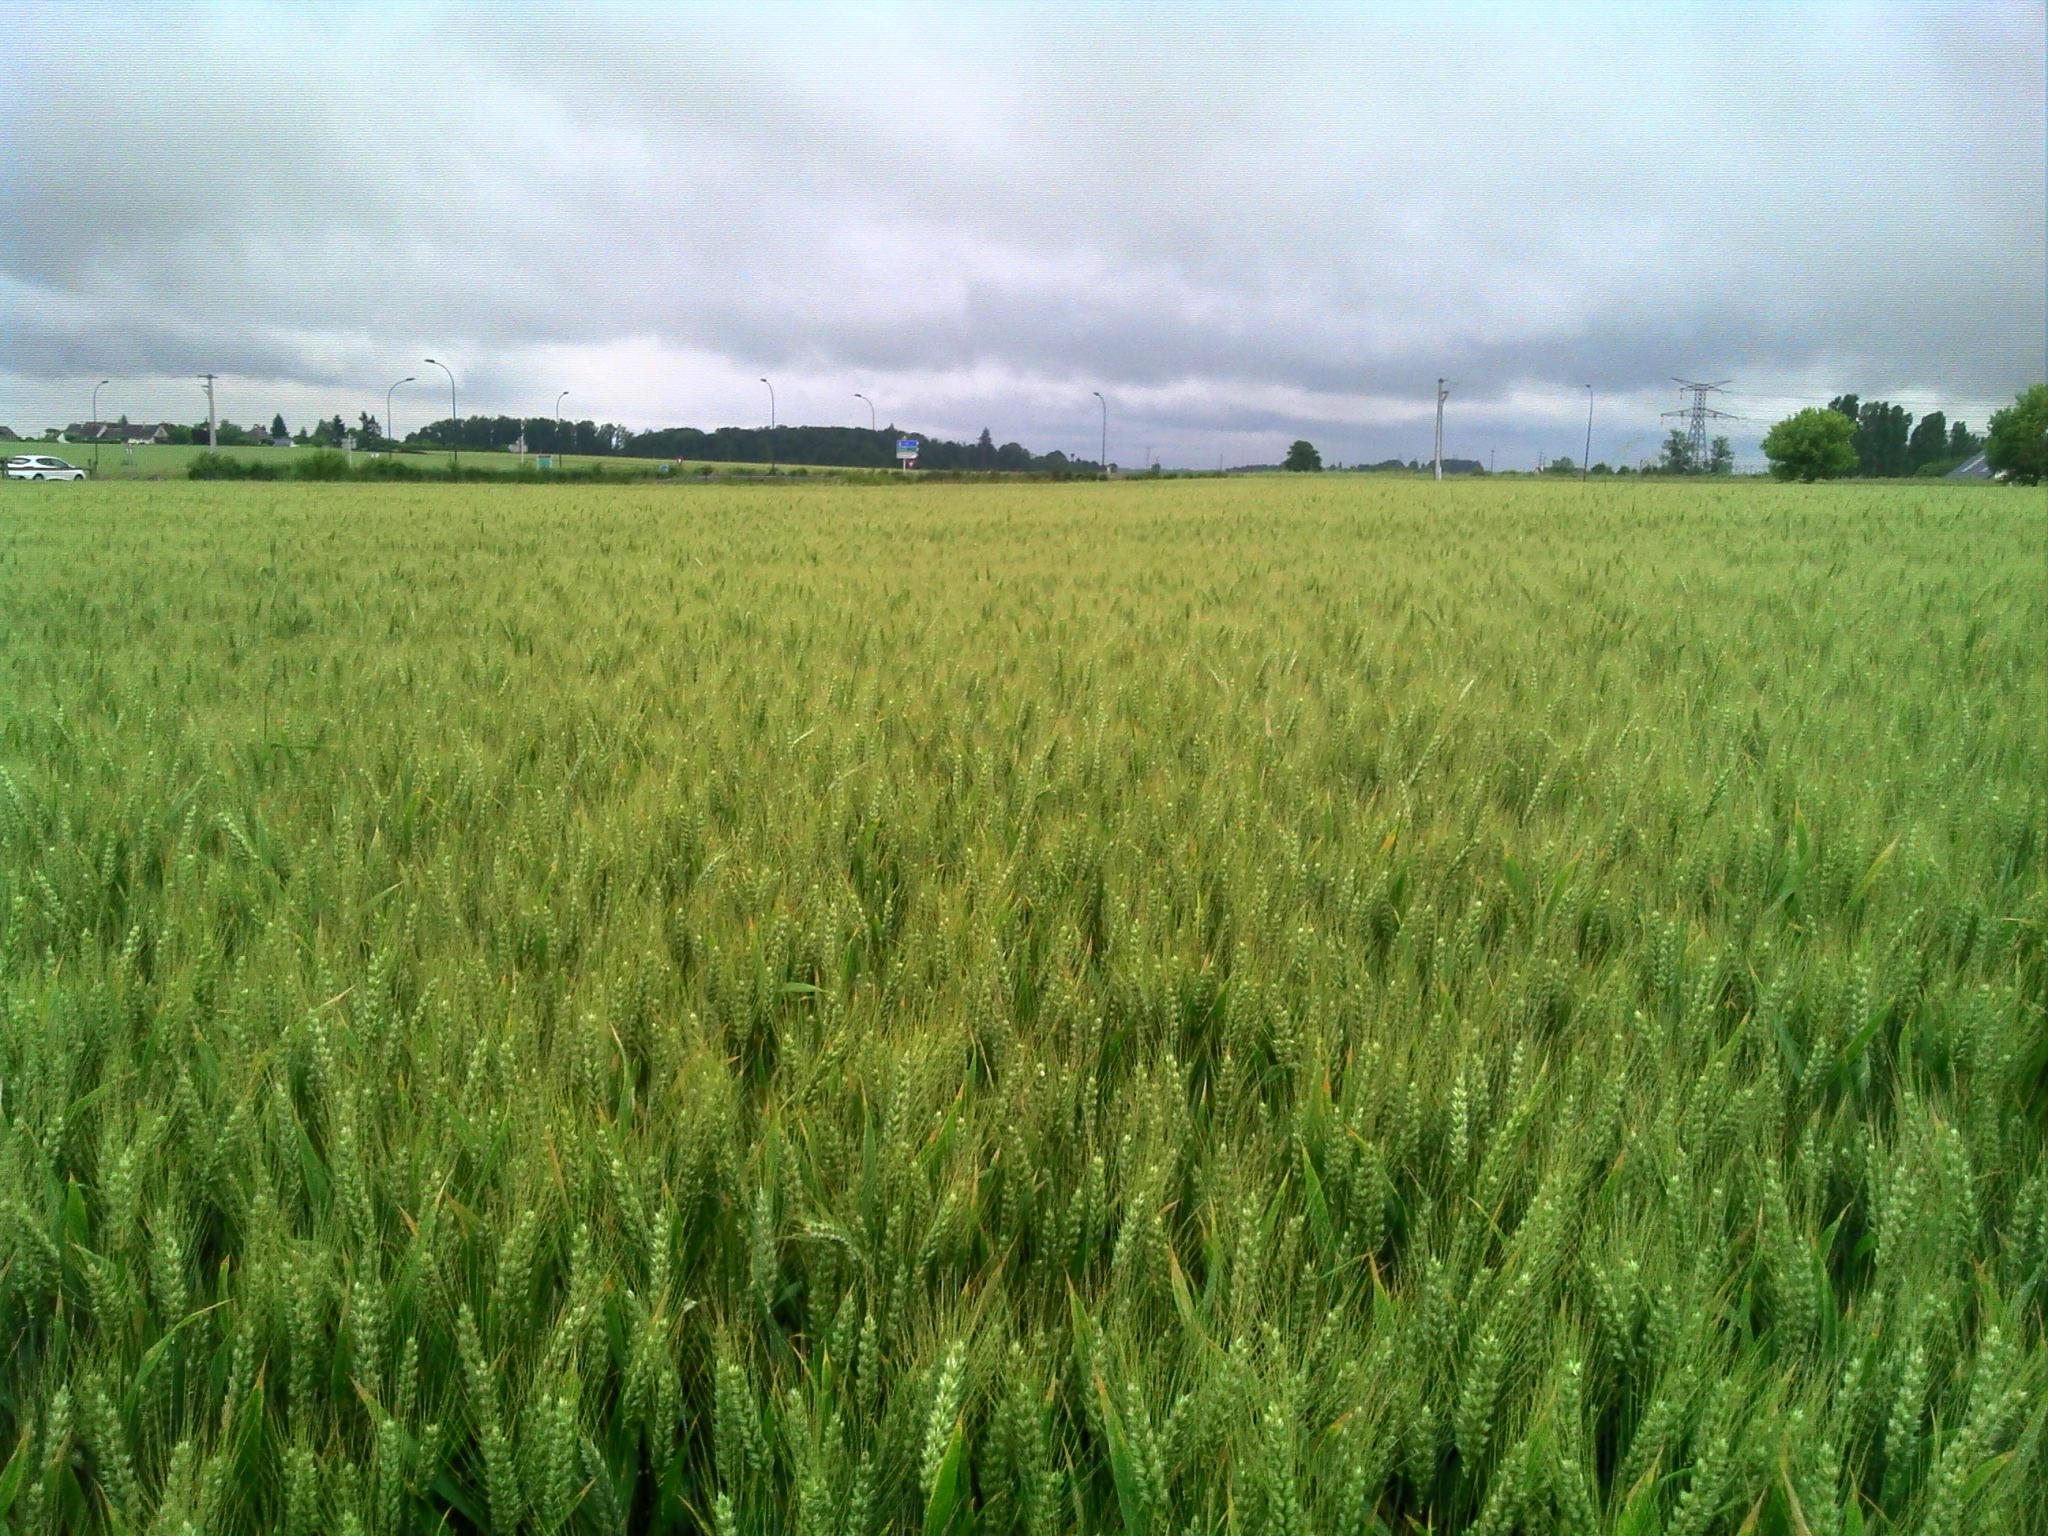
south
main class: Cropland
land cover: Common wheat
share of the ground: > 75 %
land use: Agriculture (excluding fallow land and kitchen gardens)
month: June
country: FR
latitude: 47.5727
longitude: 0.6609
